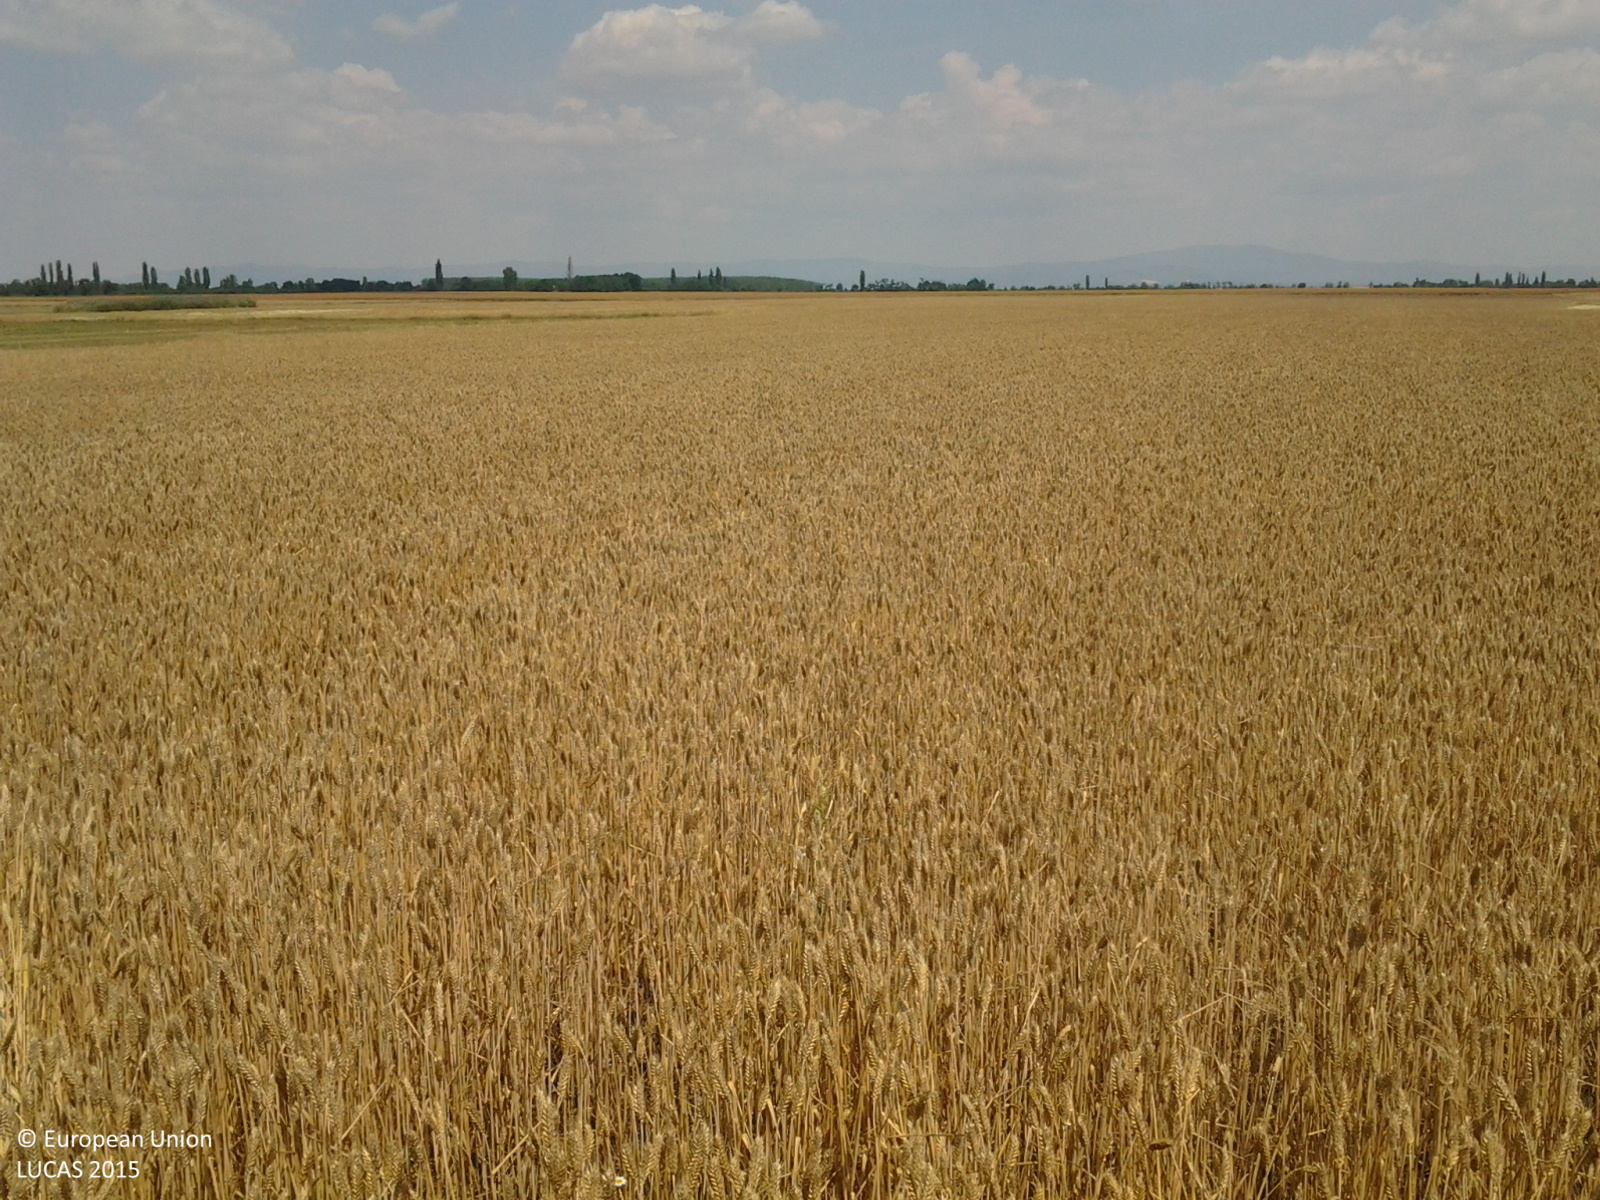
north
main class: Cropland
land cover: Common wheat
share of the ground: > 75 %
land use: Agriculture (excluding fallow land and kitchen gardens)
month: July
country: HU
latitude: 47.5950
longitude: 19.9067
